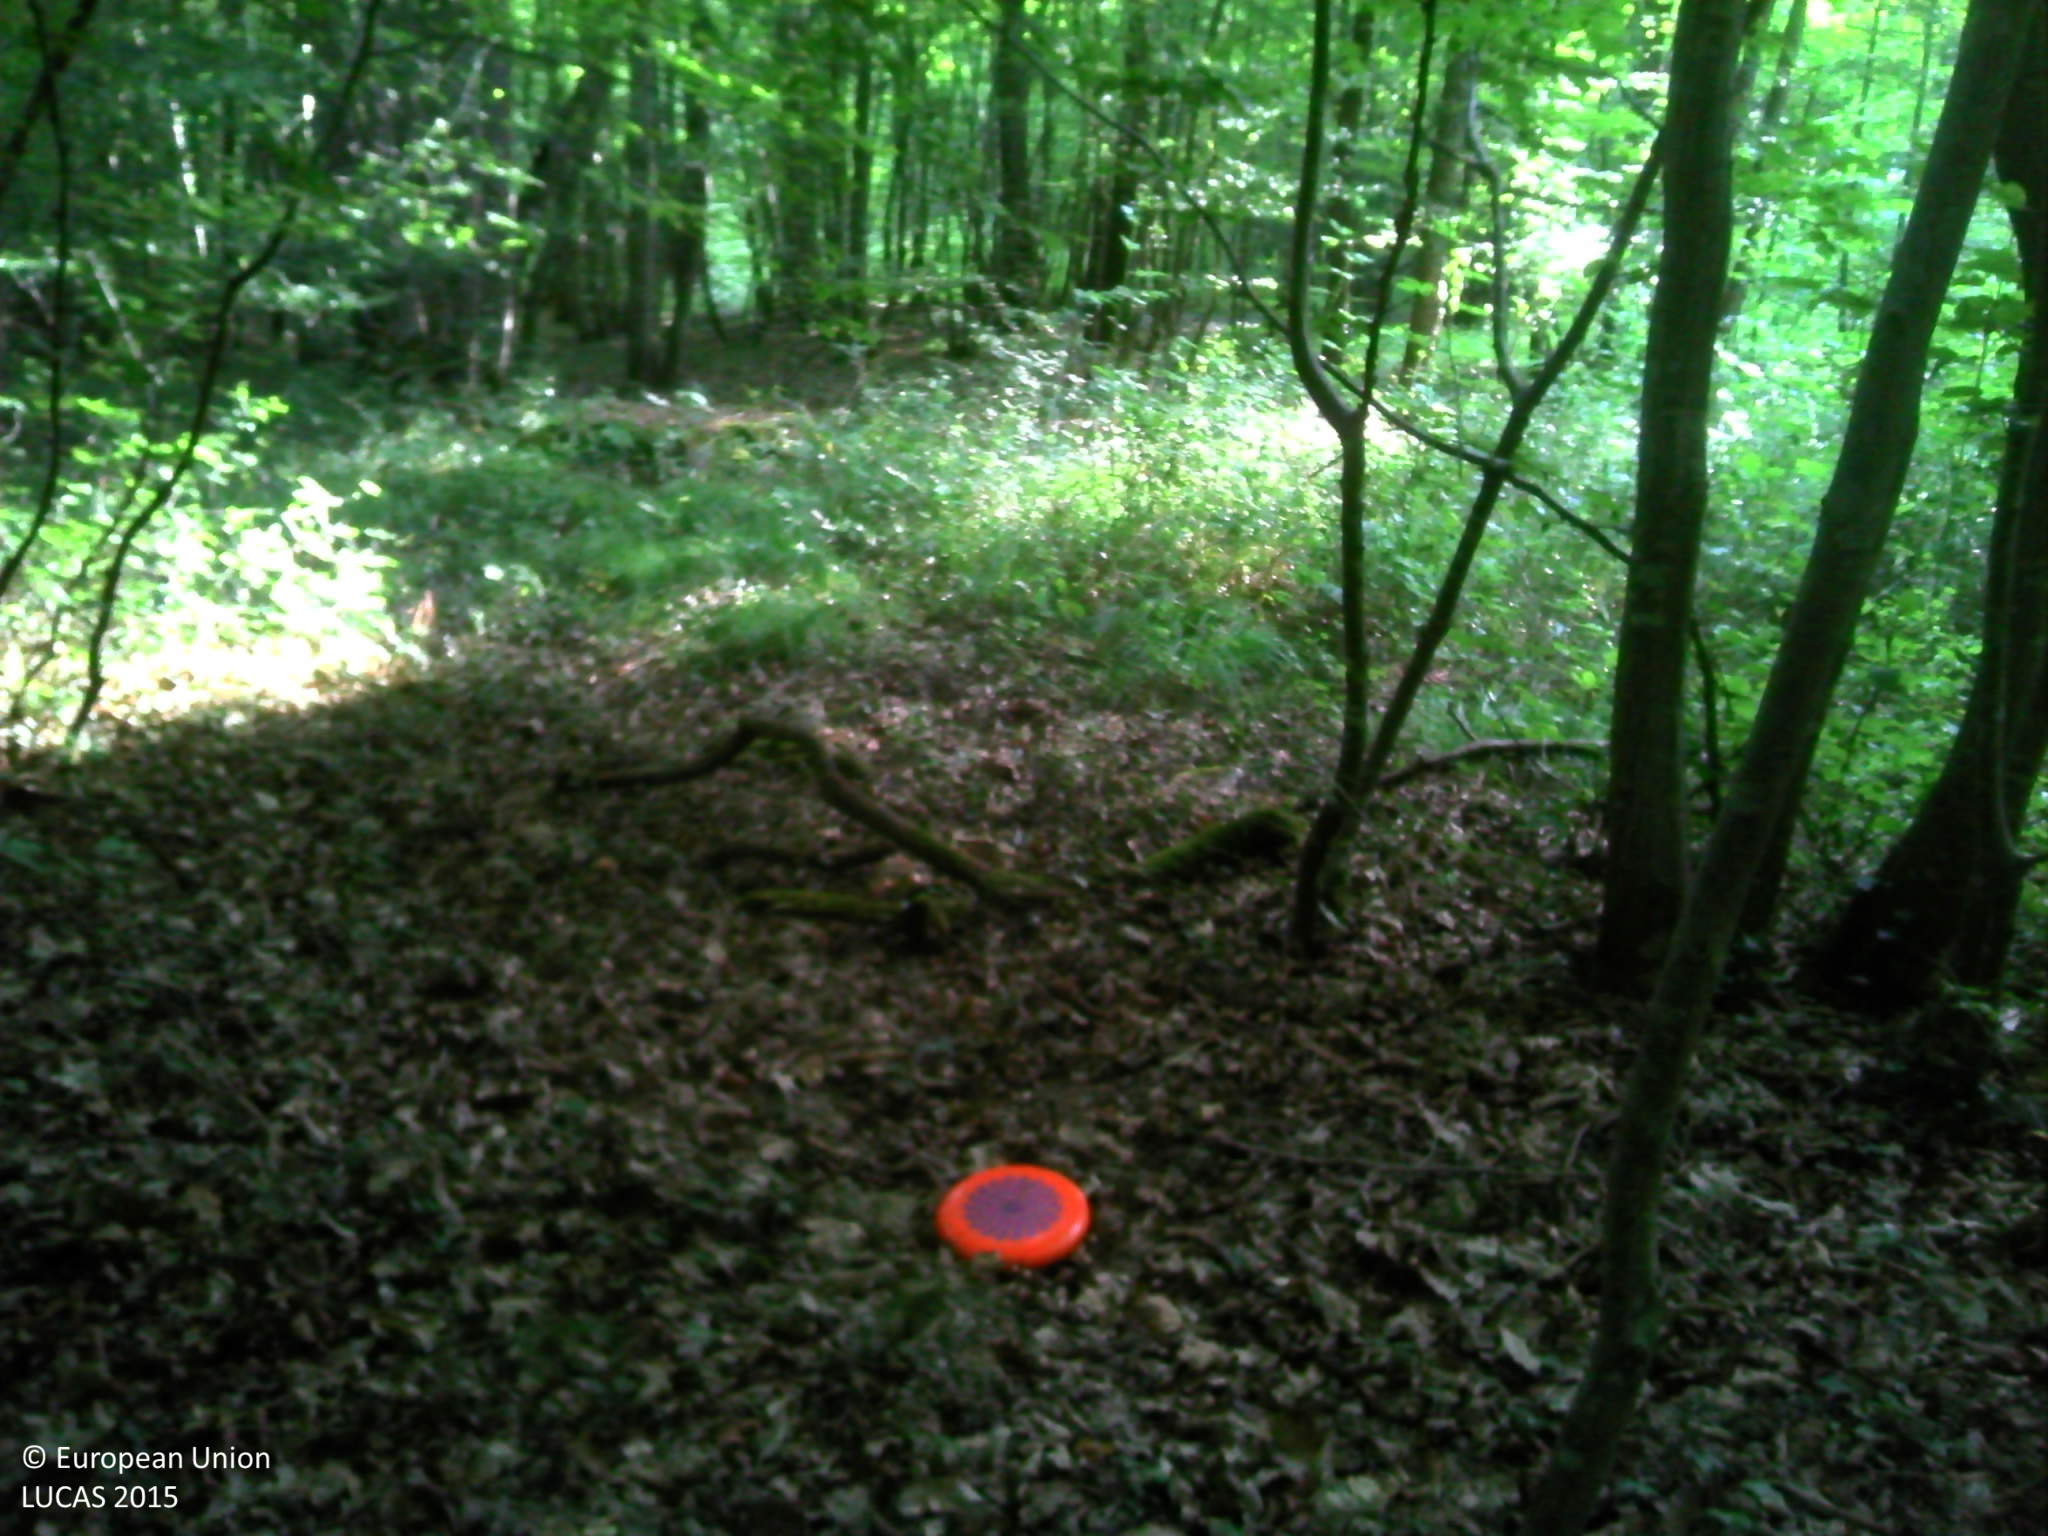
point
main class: Woodland
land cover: Broadleaved woodland
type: mesophytic deciduous forest
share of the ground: > 75 %
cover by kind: broadleaved forest trees 80 %, herbaceous plants 20 %
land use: Forestry
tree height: > 5 m
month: June
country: FR
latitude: 46.7470
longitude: 4.7785
